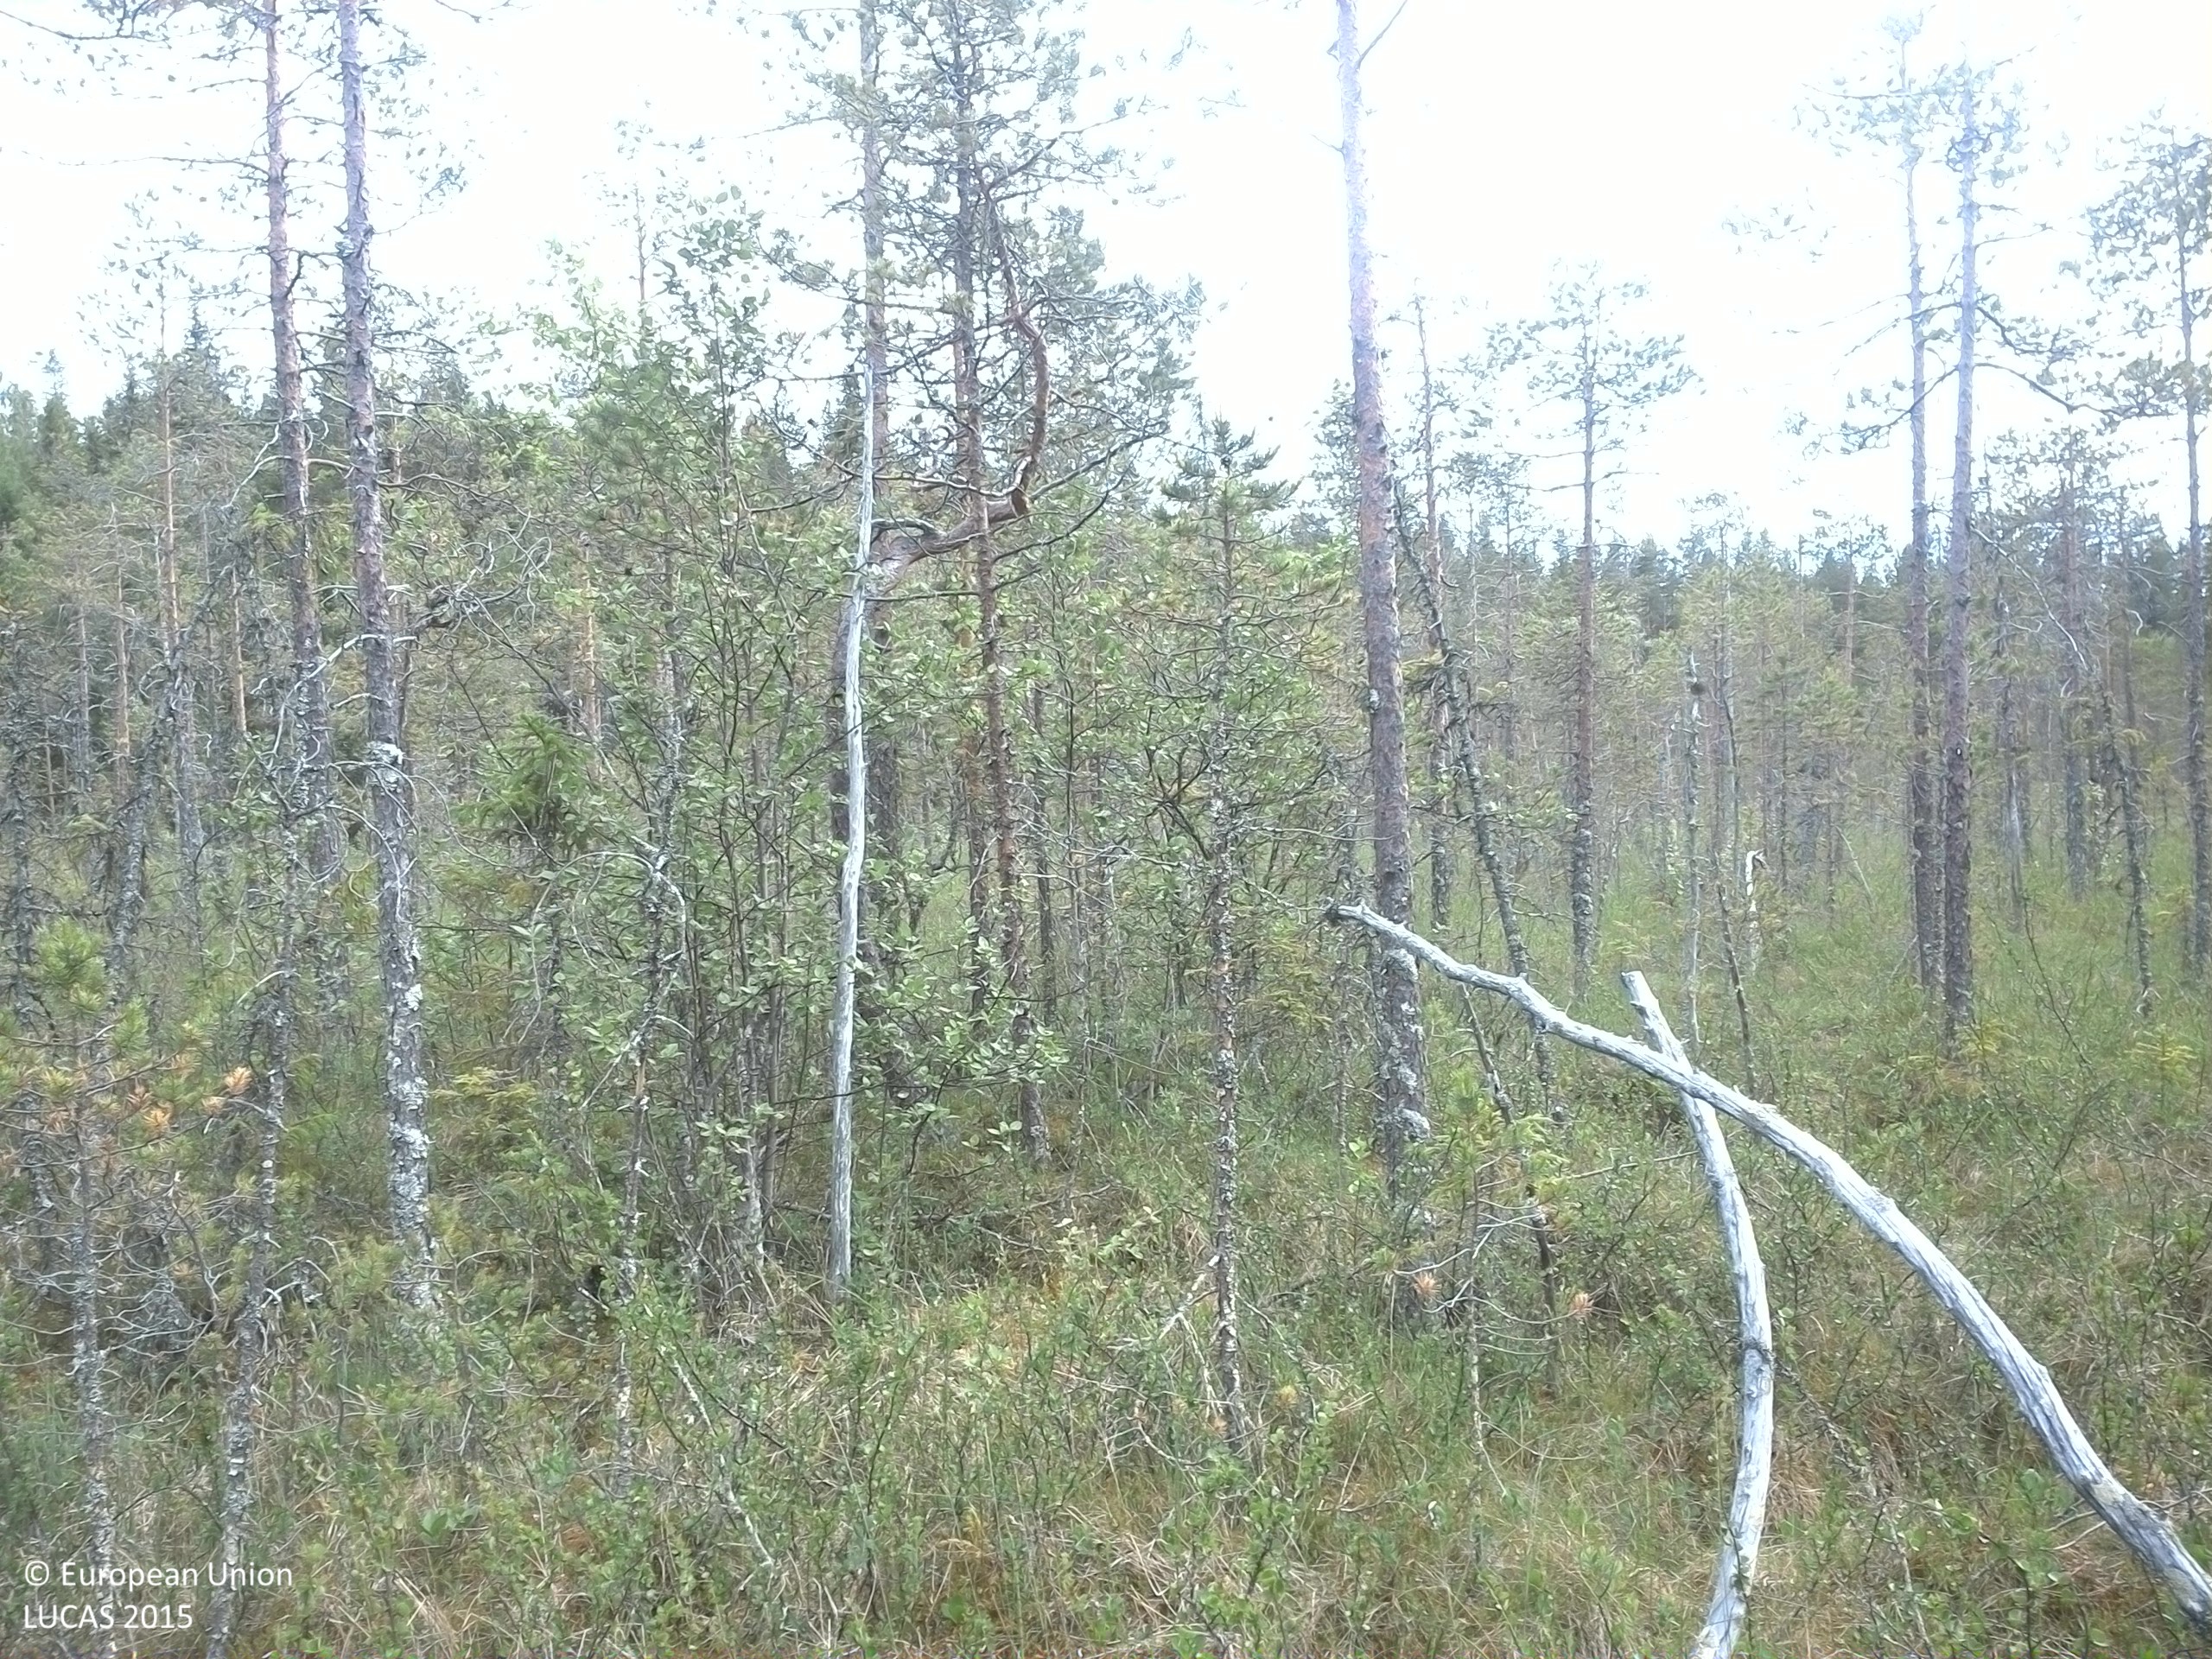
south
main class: Woodland
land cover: Pine dominated coniferous woodland
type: boreal forest
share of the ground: 25 - 50 %
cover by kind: lichens and mosses 50 %, coniferous forest trees 25 %, shrubs 10 %, herbaceous plants 10 %, broadleaved forest trees 5 %
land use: Forestry
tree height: < 5 m
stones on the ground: < 10 %
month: July
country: SE
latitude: 63.5705
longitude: 17.8074
